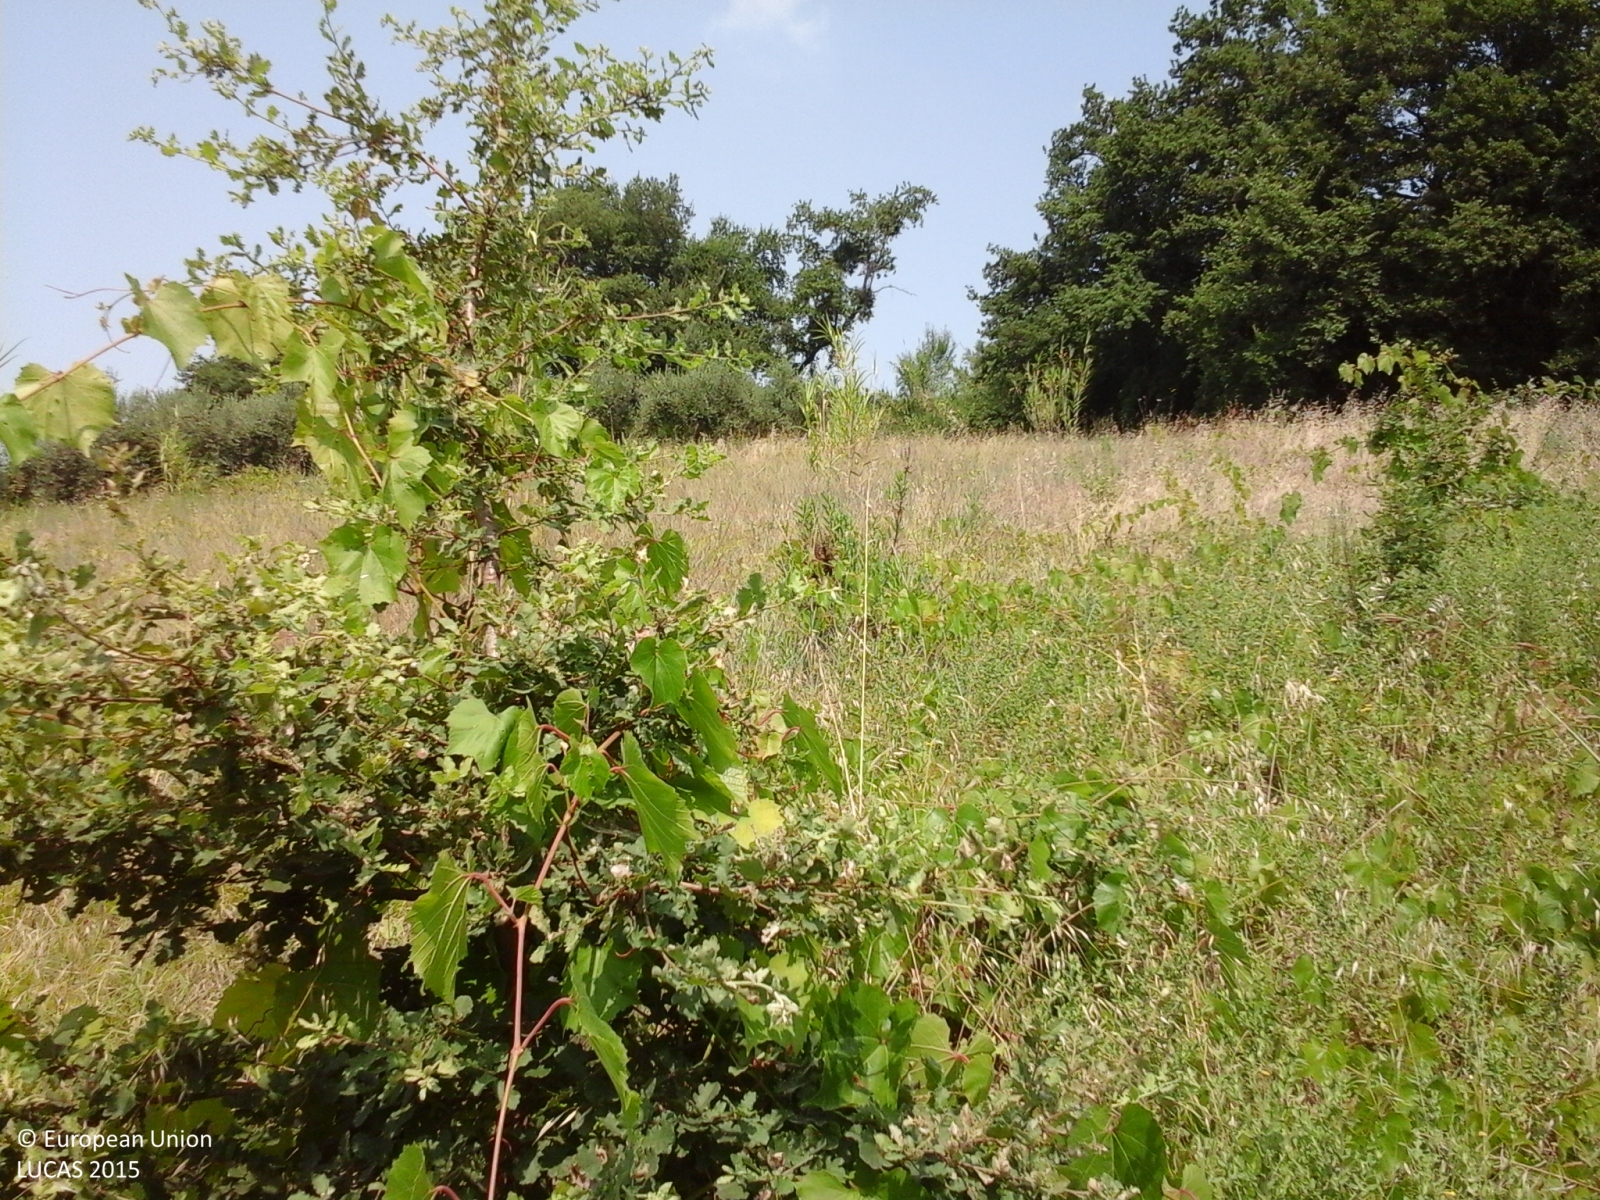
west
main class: Shrubland
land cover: Shrubland with sparse tree cover
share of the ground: 50 - 75 %
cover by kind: shrubs 90 %, broadleaved forest trees 5 %, herbaceous plants 5 %
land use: Abandoned areas
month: July
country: IT
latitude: 42.3479
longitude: 14.2480
